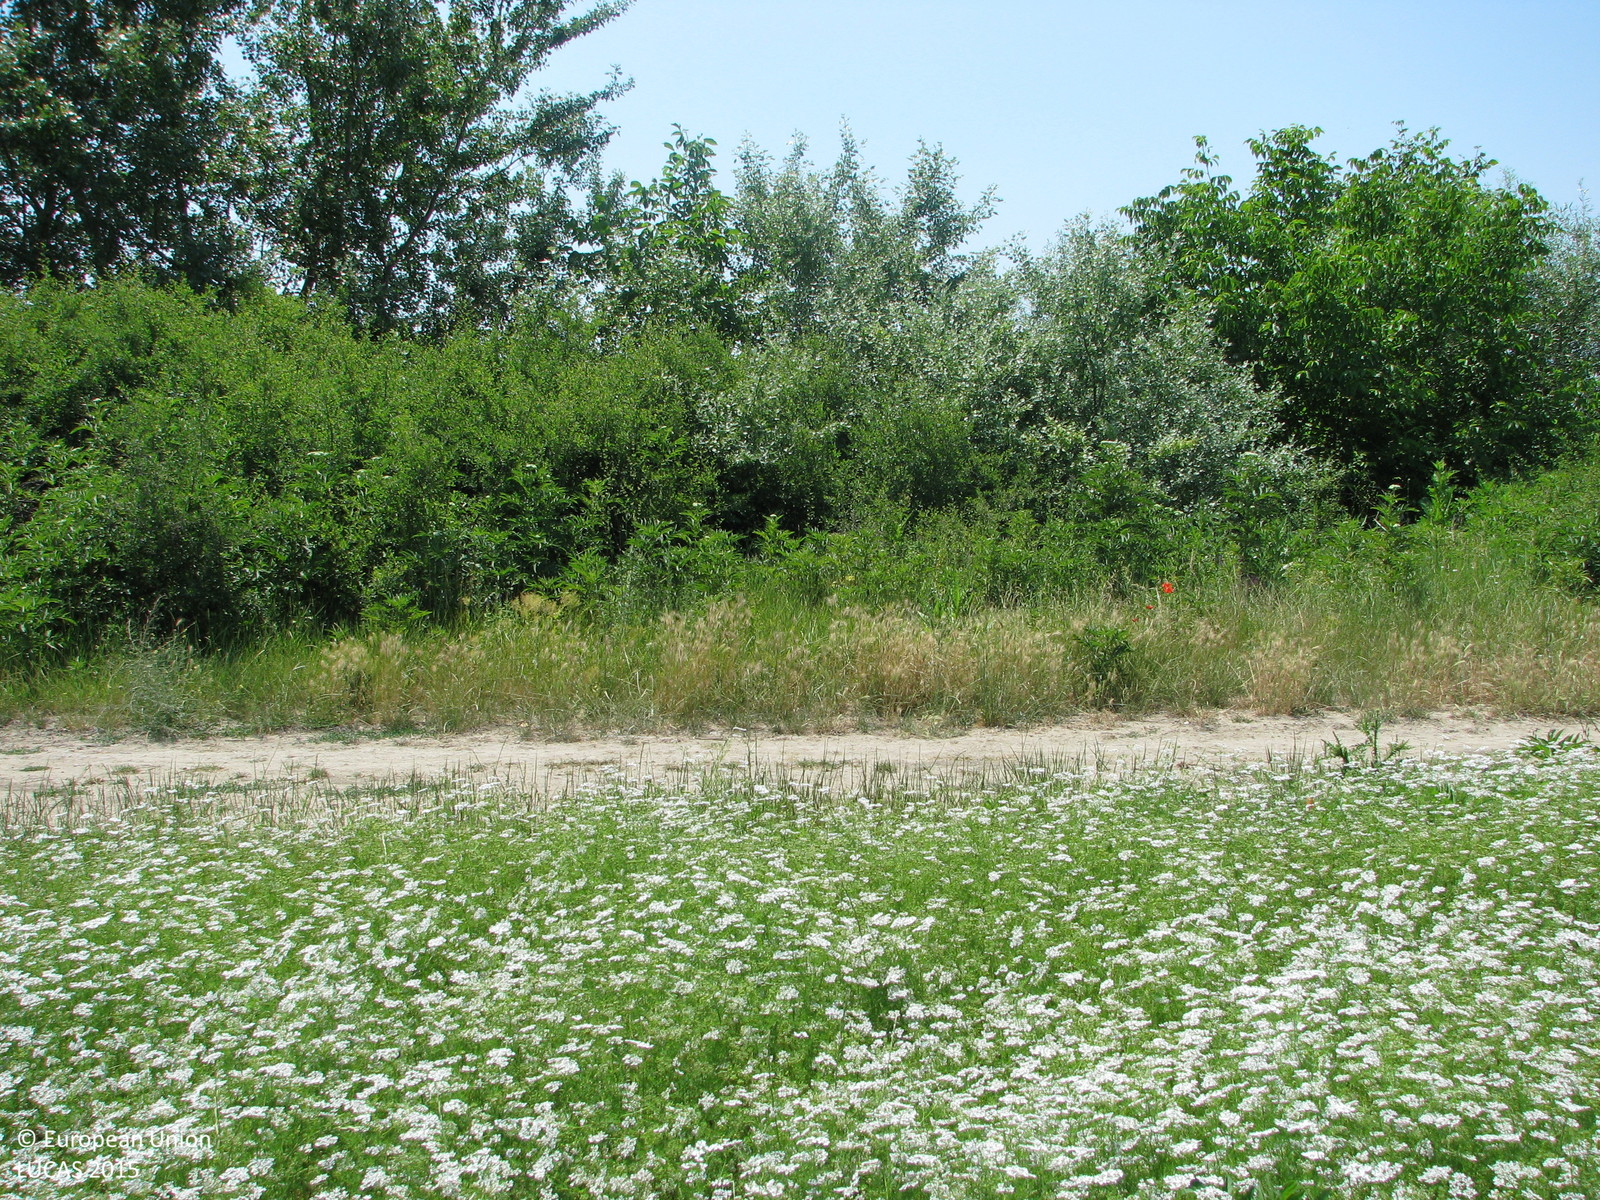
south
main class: Cropland
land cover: Other non-permanent industrial crops
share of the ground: > 75 %
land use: Agriculture (excluding fallow land and kitchen gardens)
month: June
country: BG
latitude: 42.6118
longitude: 26.2897
